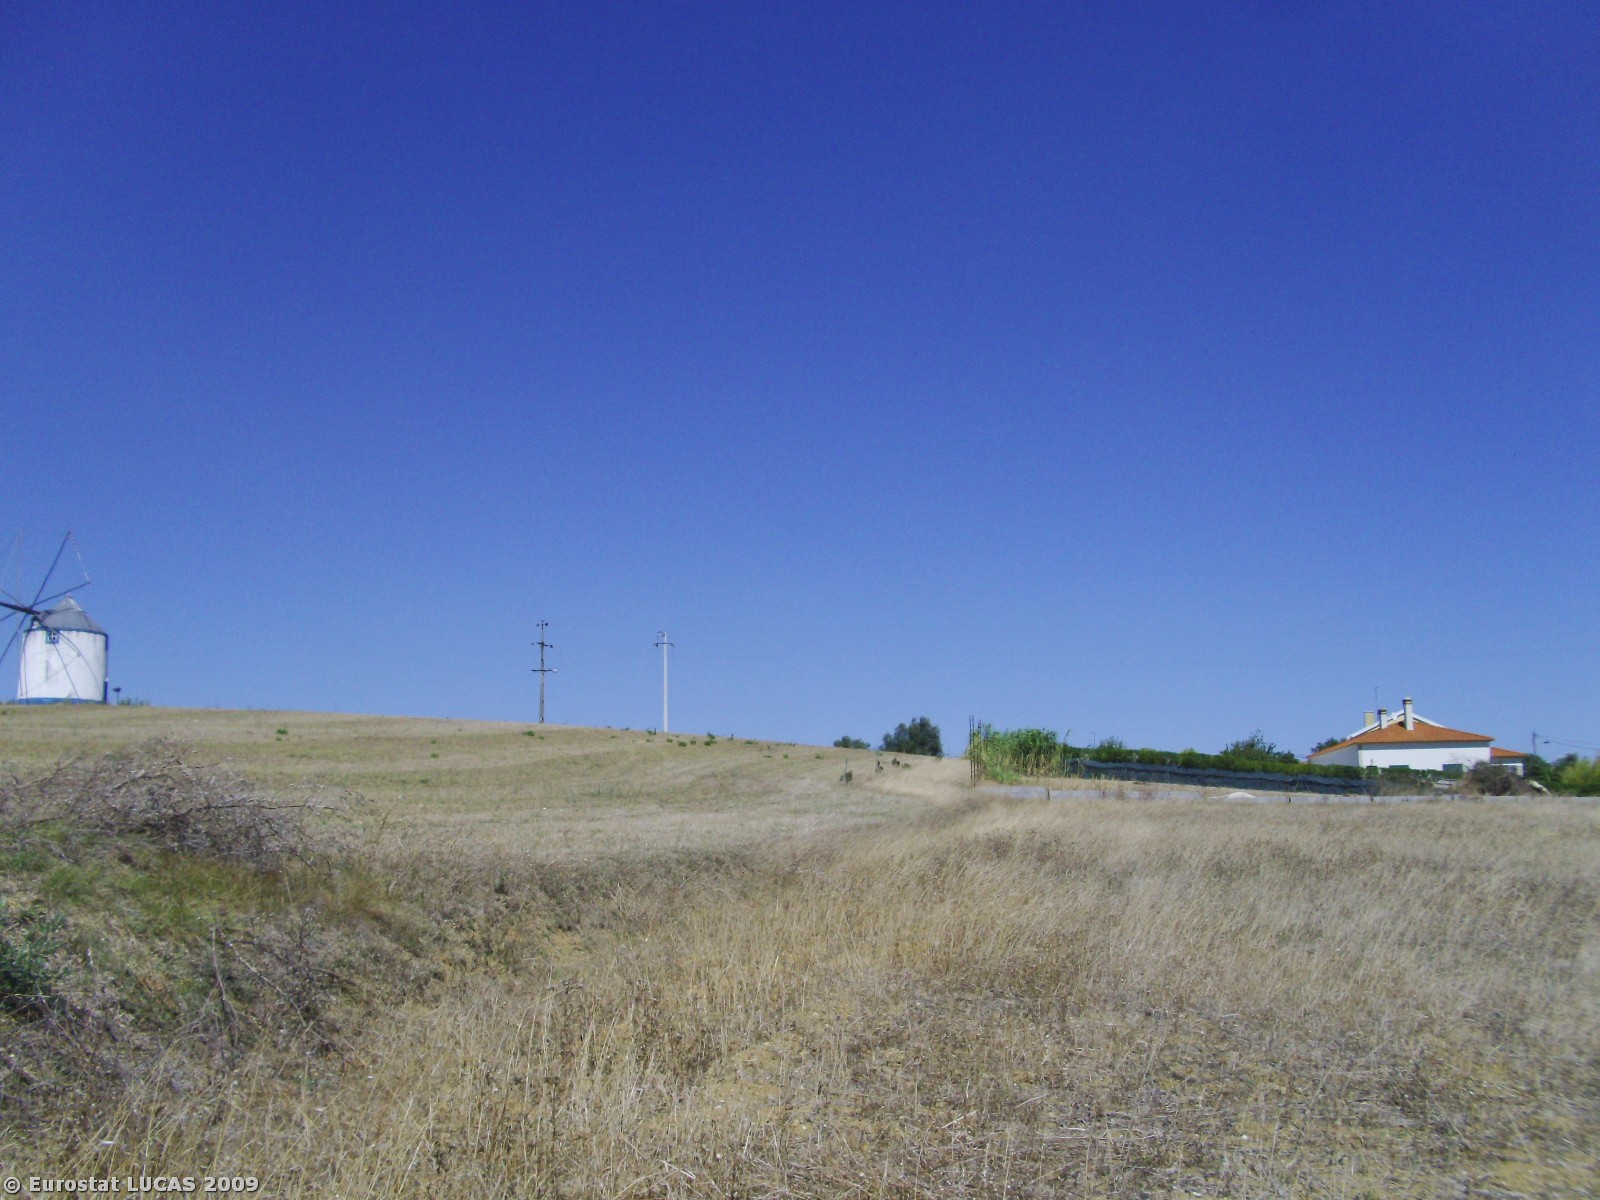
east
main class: Grassland
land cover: Grassland without tree/shrub cover
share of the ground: > 75 %
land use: Agriculture (excluding fallow land and kitchen gardens)
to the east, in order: Grassland without tree/shrub cover; Dry stone walls; Grassland without tree/shrub cover; Artificial constructions in urban areas; Dry stone walls; Permanent crops (only in case pi); Dry stone walls; Spontaneously vegetated surfaces; Tracks; Artificial constructions in urban areas; Spontaneously vegetated surfaces
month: July
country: PT
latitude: 39.1779
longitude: -8.8639
